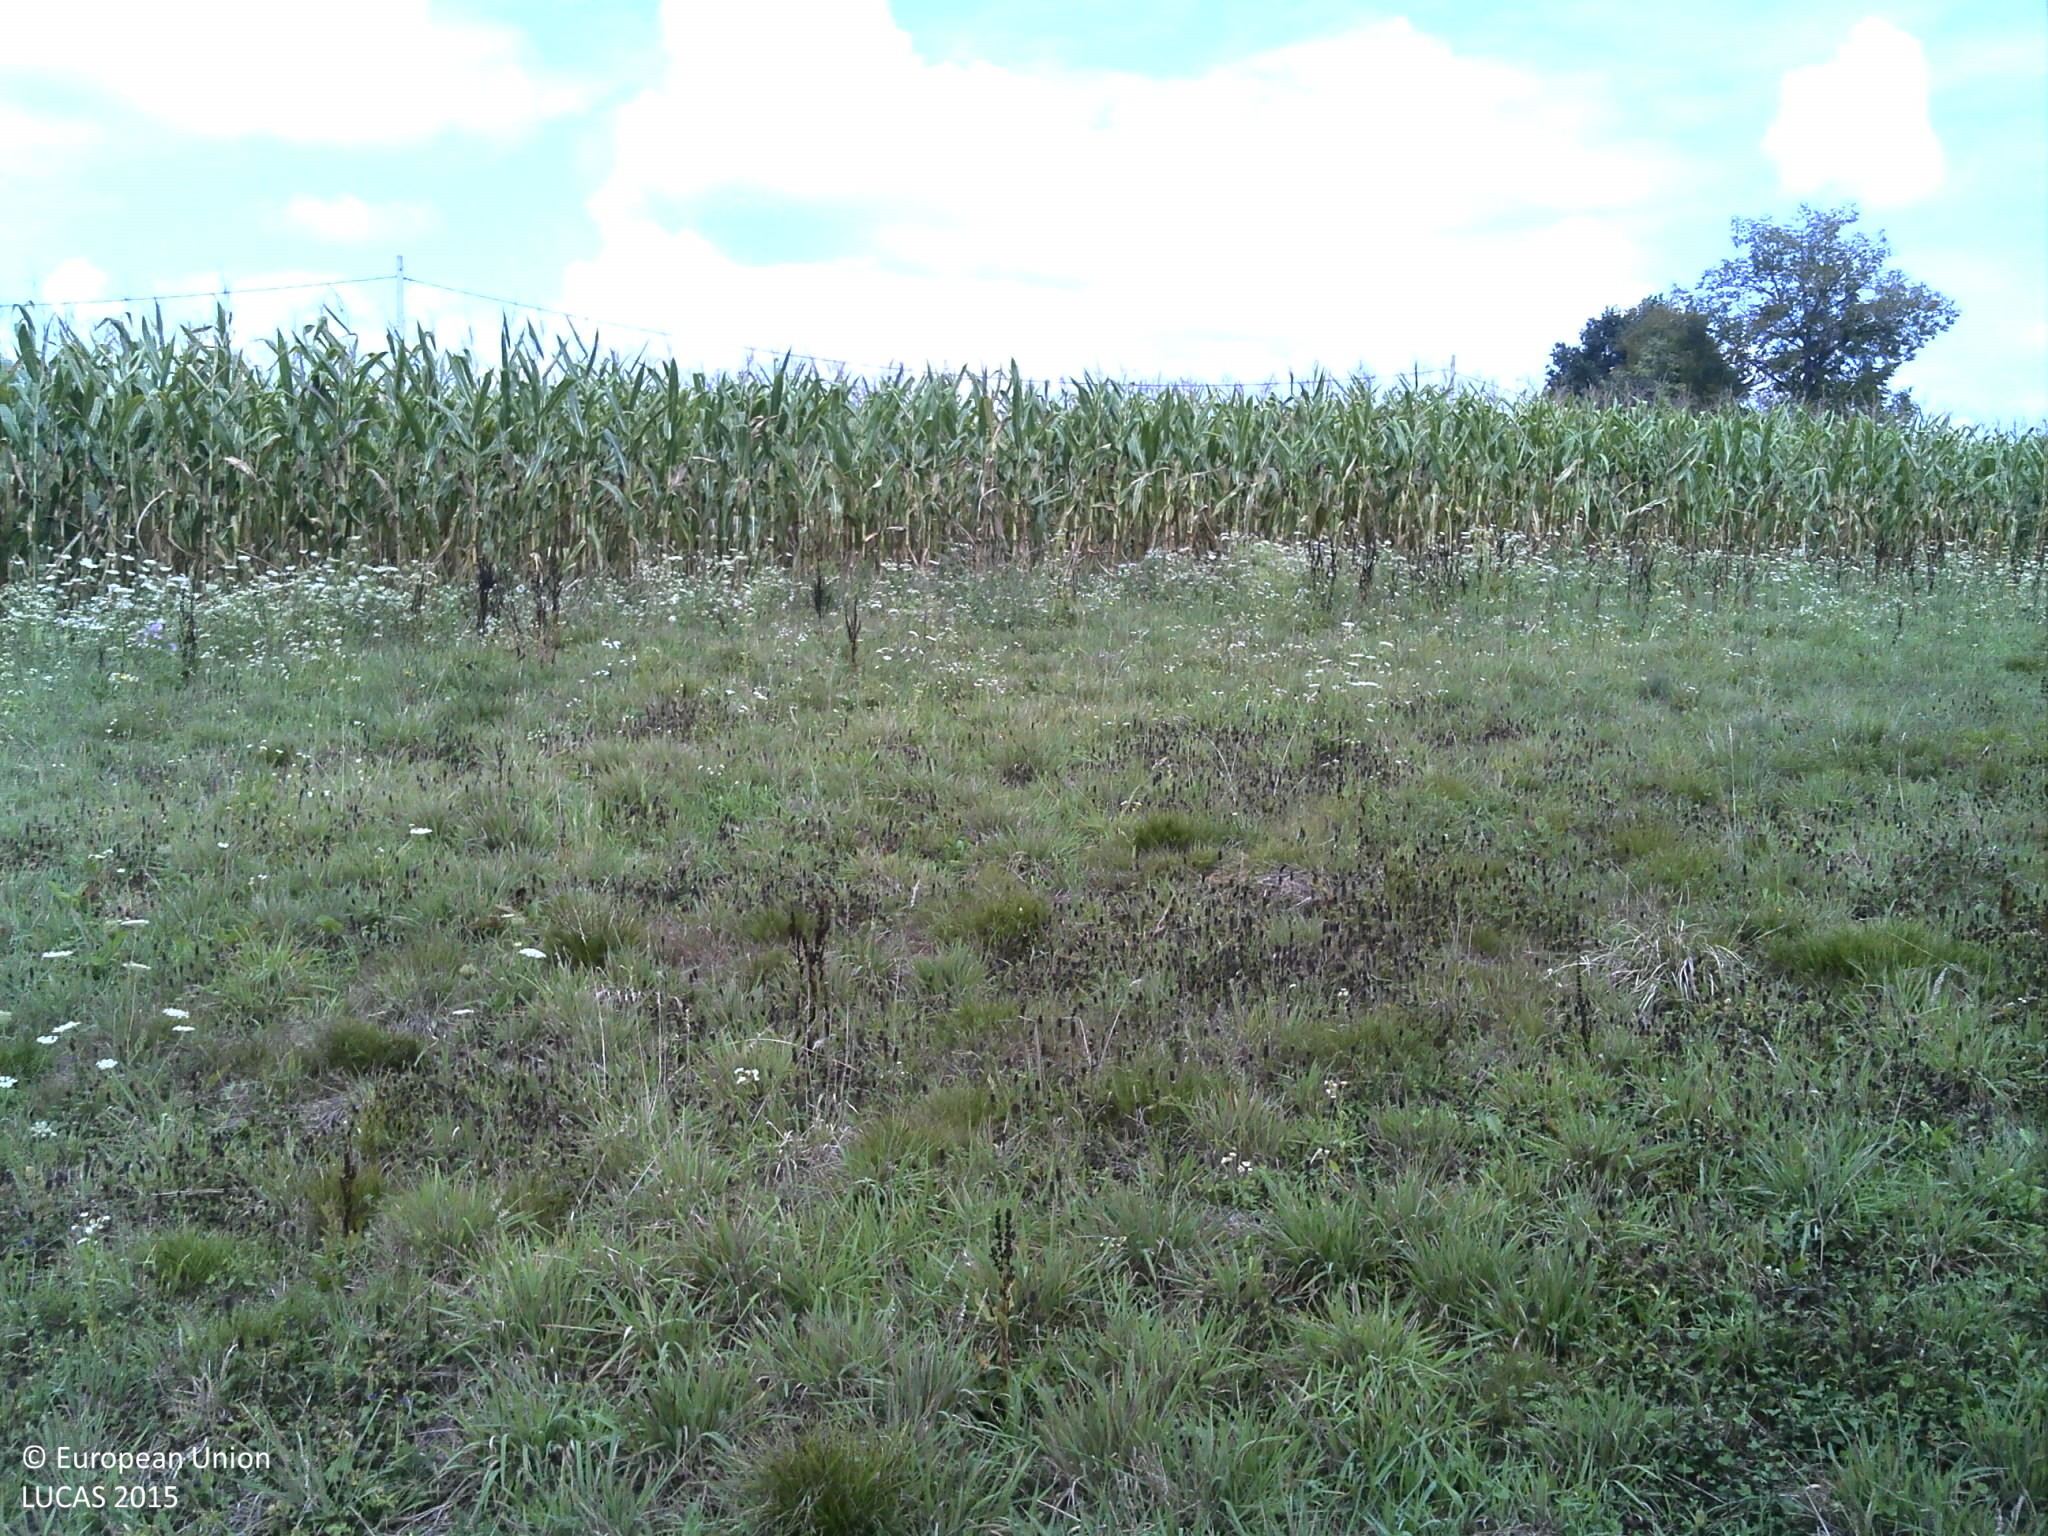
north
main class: Grassland
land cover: Spontaneously vegetated surfaces
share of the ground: > 75 %
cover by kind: herbaceous plants 100 %
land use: Fallow land
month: August
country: HR
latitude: 45.3334
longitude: 16.0066
